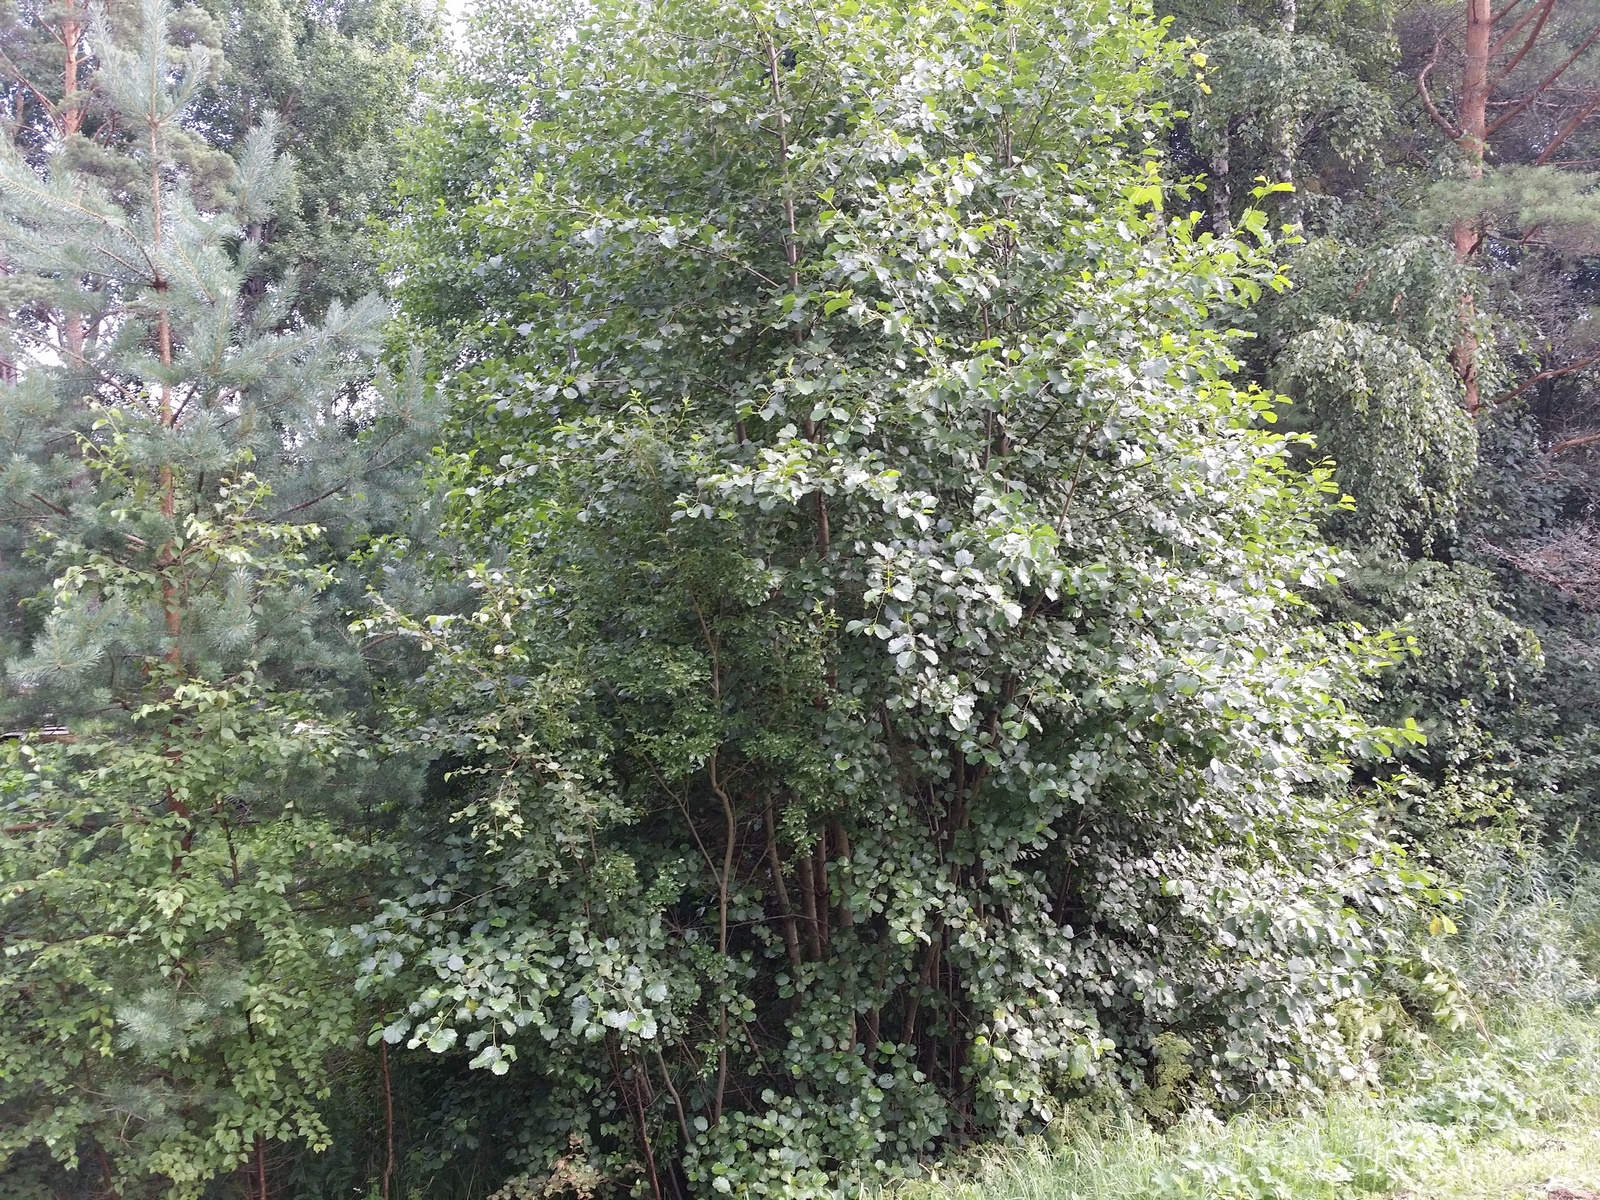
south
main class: Grassland
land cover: Grassland without tree/shrub cover
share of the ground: > 75 %
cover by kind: herbaceous plants 95 %, unconsolidated bare surface 5 %
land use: Residential
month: August
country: LV
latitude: 57.3798
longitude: 26.7329
